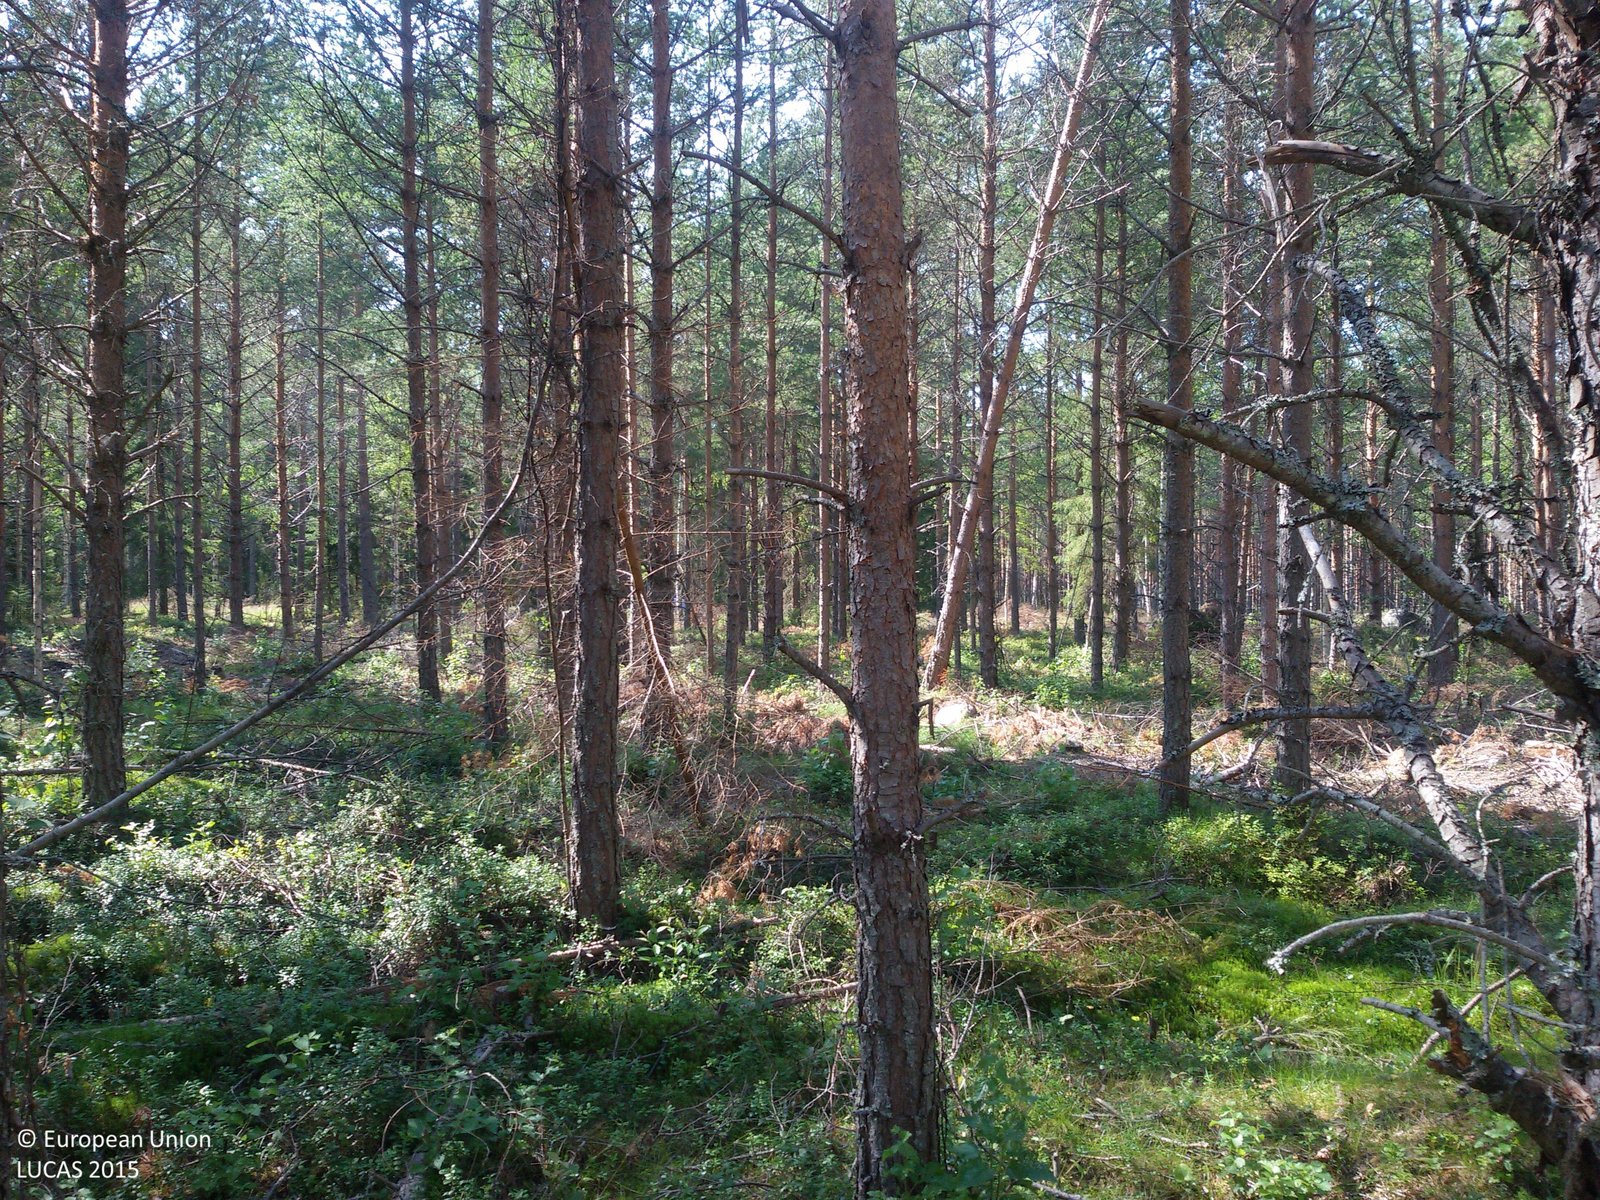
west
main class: Woodland
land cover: Pine dominated coniferous woodland
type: boreal forest
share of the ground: > 75 %
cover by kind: coniferous forest trees 80 %, shrubs 20 %
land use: Forestry
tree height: > 5 m
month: August
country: SE
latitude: 60.4800
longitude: 16.5569
